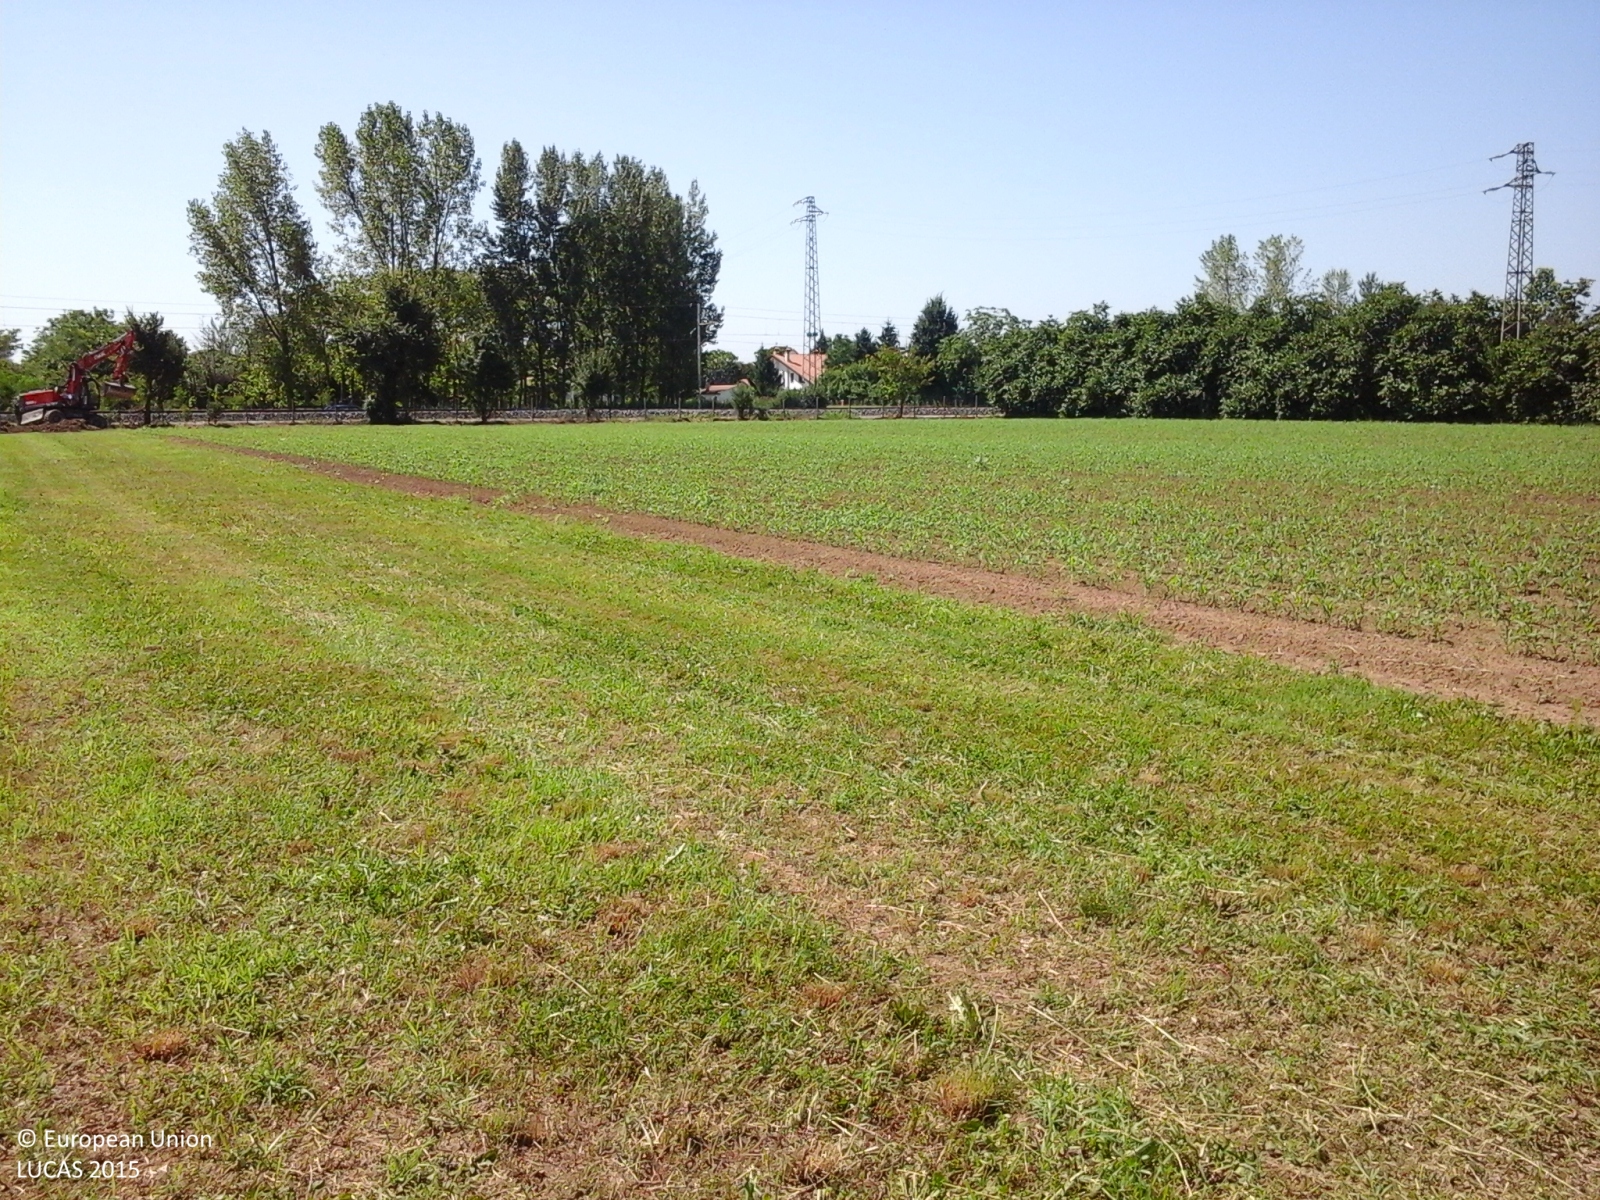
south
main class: Grassland
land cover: Grassland without tree/shrub cover
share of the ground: > 75 %
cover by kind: herbaceous plants 100 %
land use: Agriculture (excluding fallow land and kitchen gardens)
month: July
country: IT
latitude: 45.6772
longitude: 12.3203
